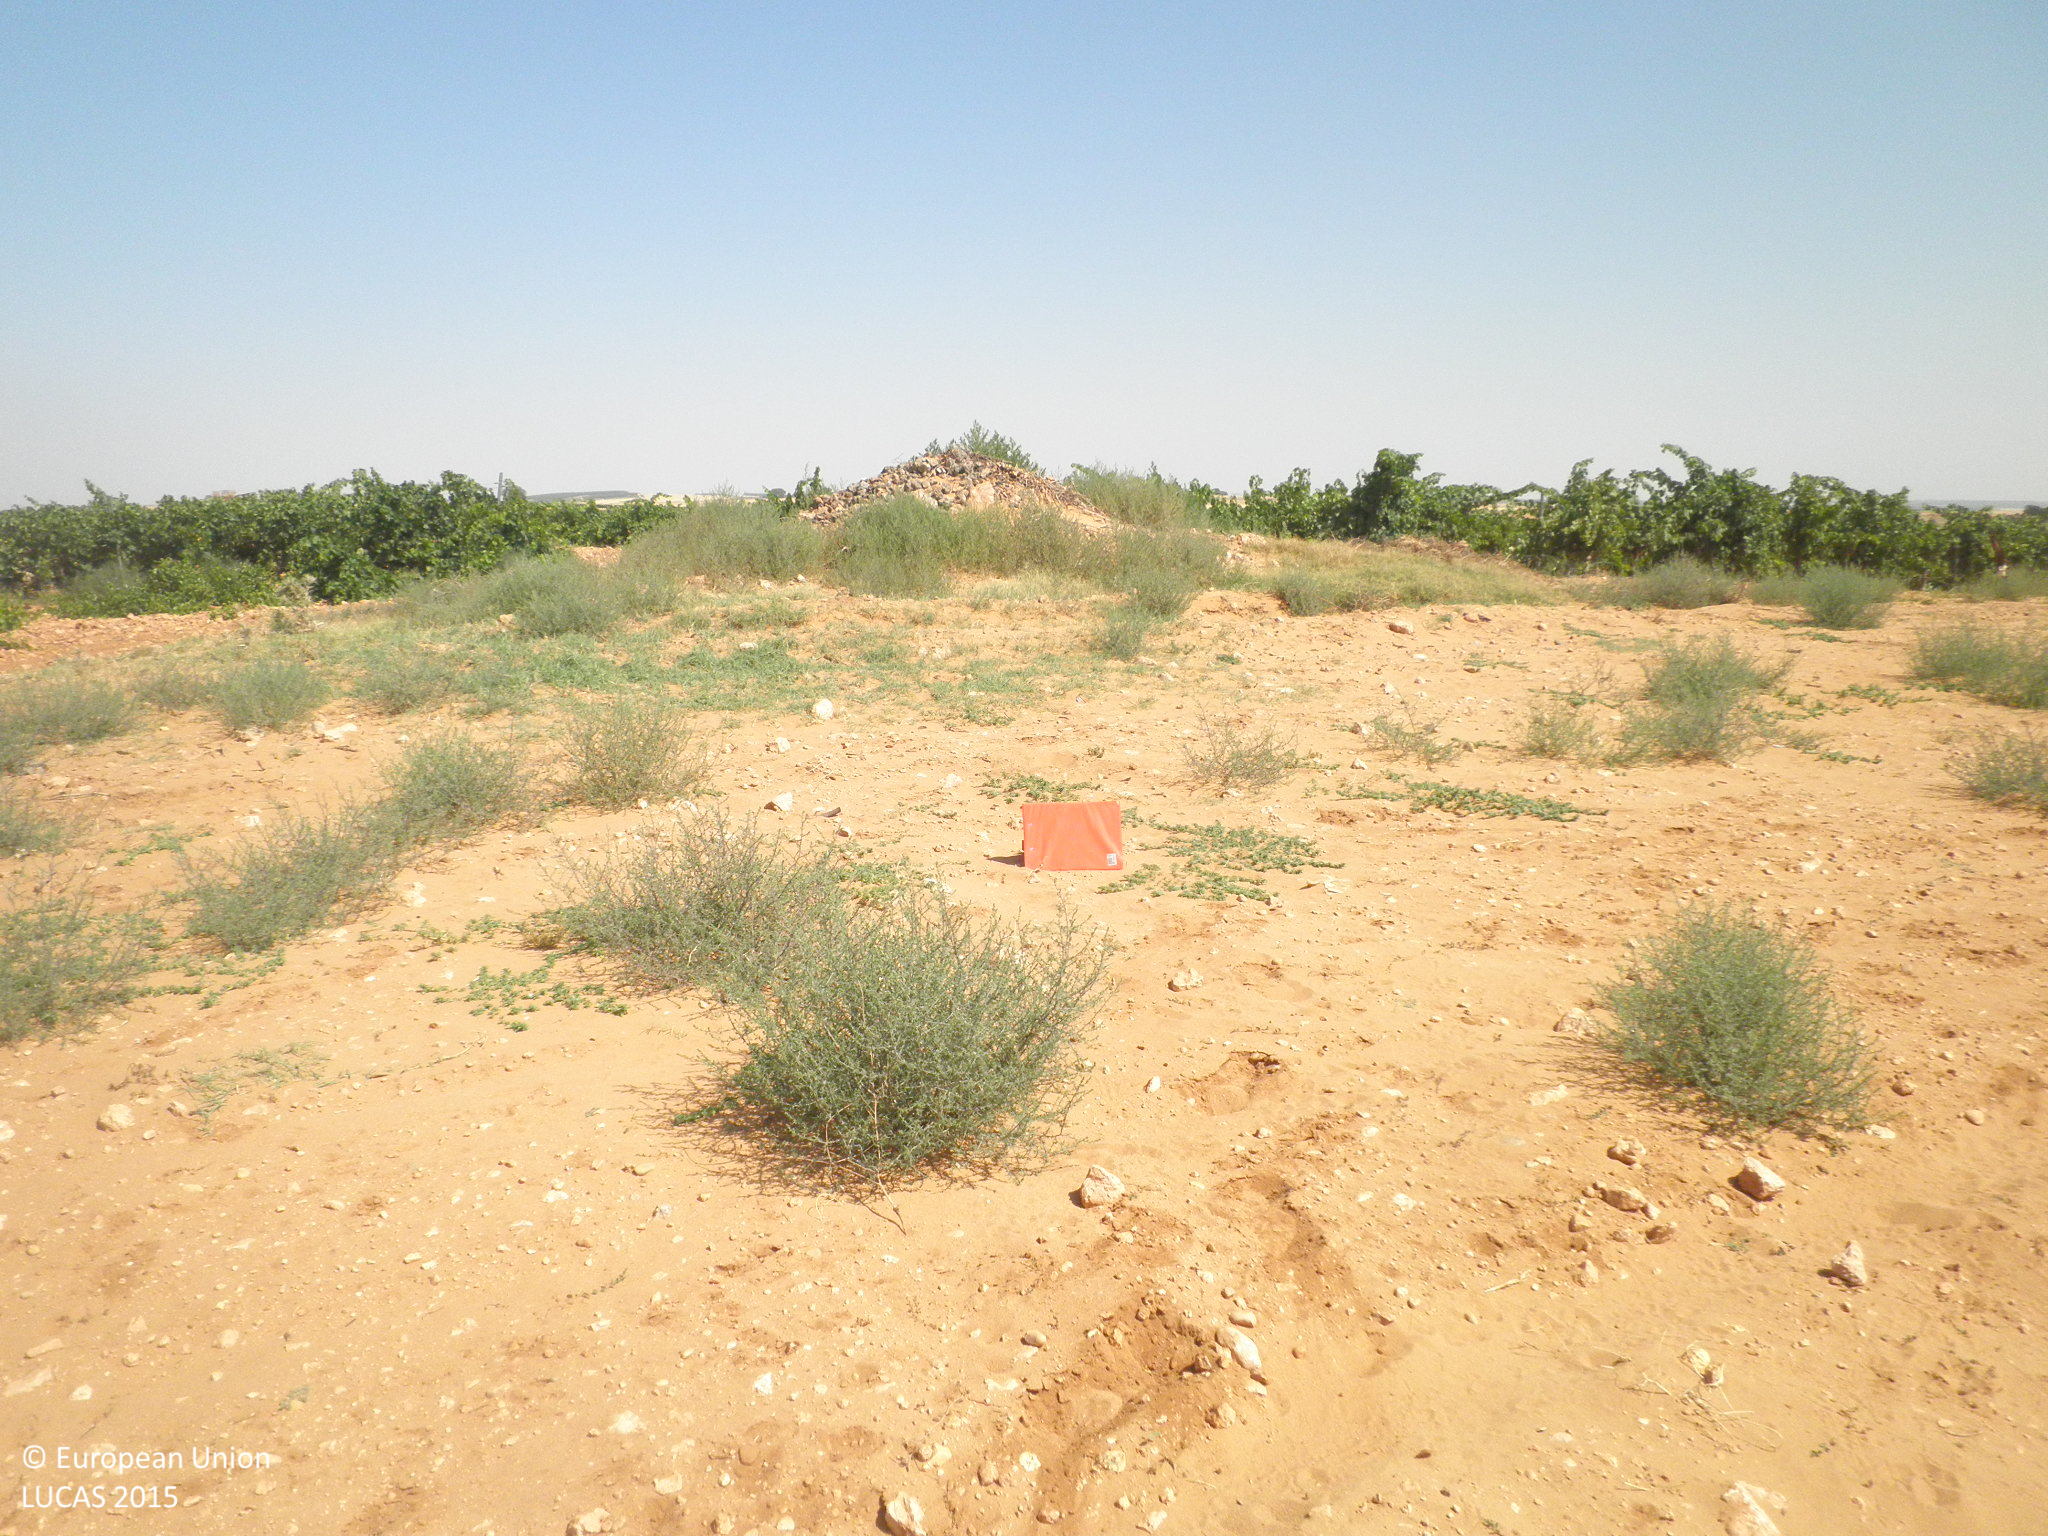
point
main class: Grassland
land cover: Spontaneously vegetated surfaces
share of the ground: 10 - 25 %
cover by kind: unconsolidated bare surface 90 %, herbaceous plants 10 %
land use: Fallow land
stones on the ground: 10 - 25 %
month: July
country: ES
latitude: 39.4339
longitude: -2.5944
